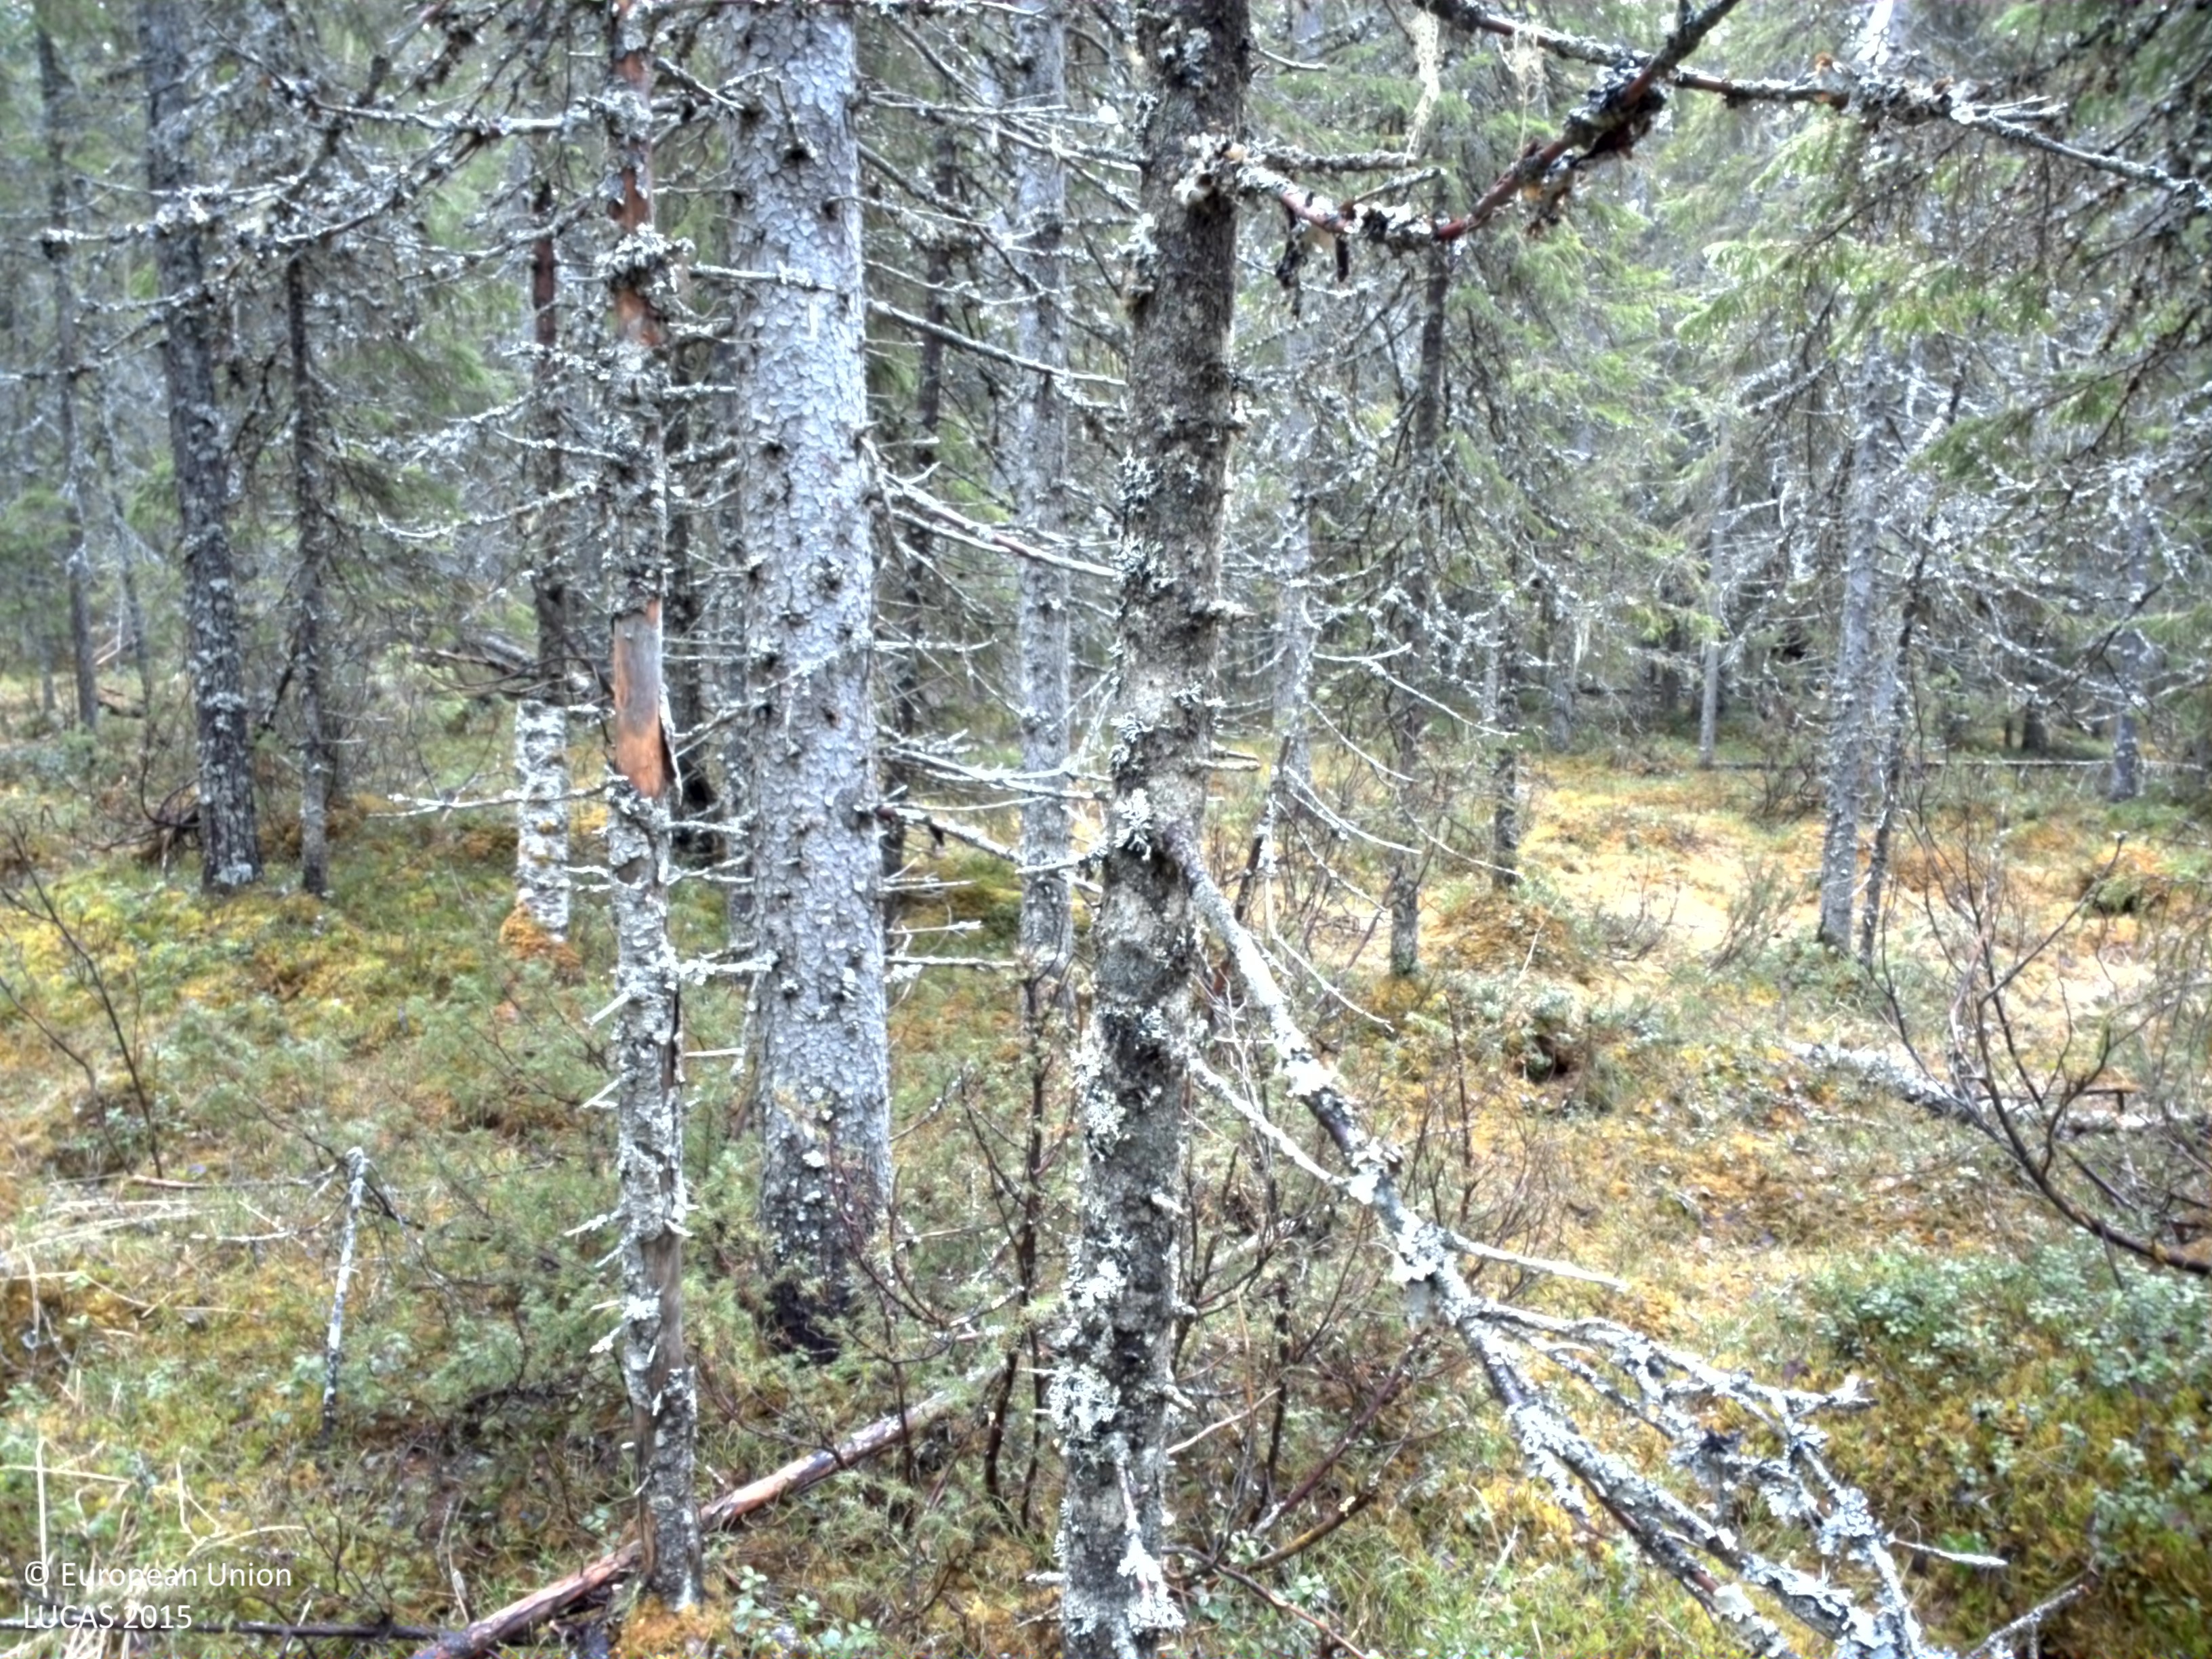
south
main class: Woodland
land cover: Spruce dominated coniferous woodland
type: boreal forest
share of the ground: > 75 %
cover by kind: coniferous forest trees 75 %, shrubs 20 %, broadleaved forest trees 5 %
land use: Forestry
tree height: > 5 m
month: May
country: SE
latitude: 63.4478
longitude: 13.8503
